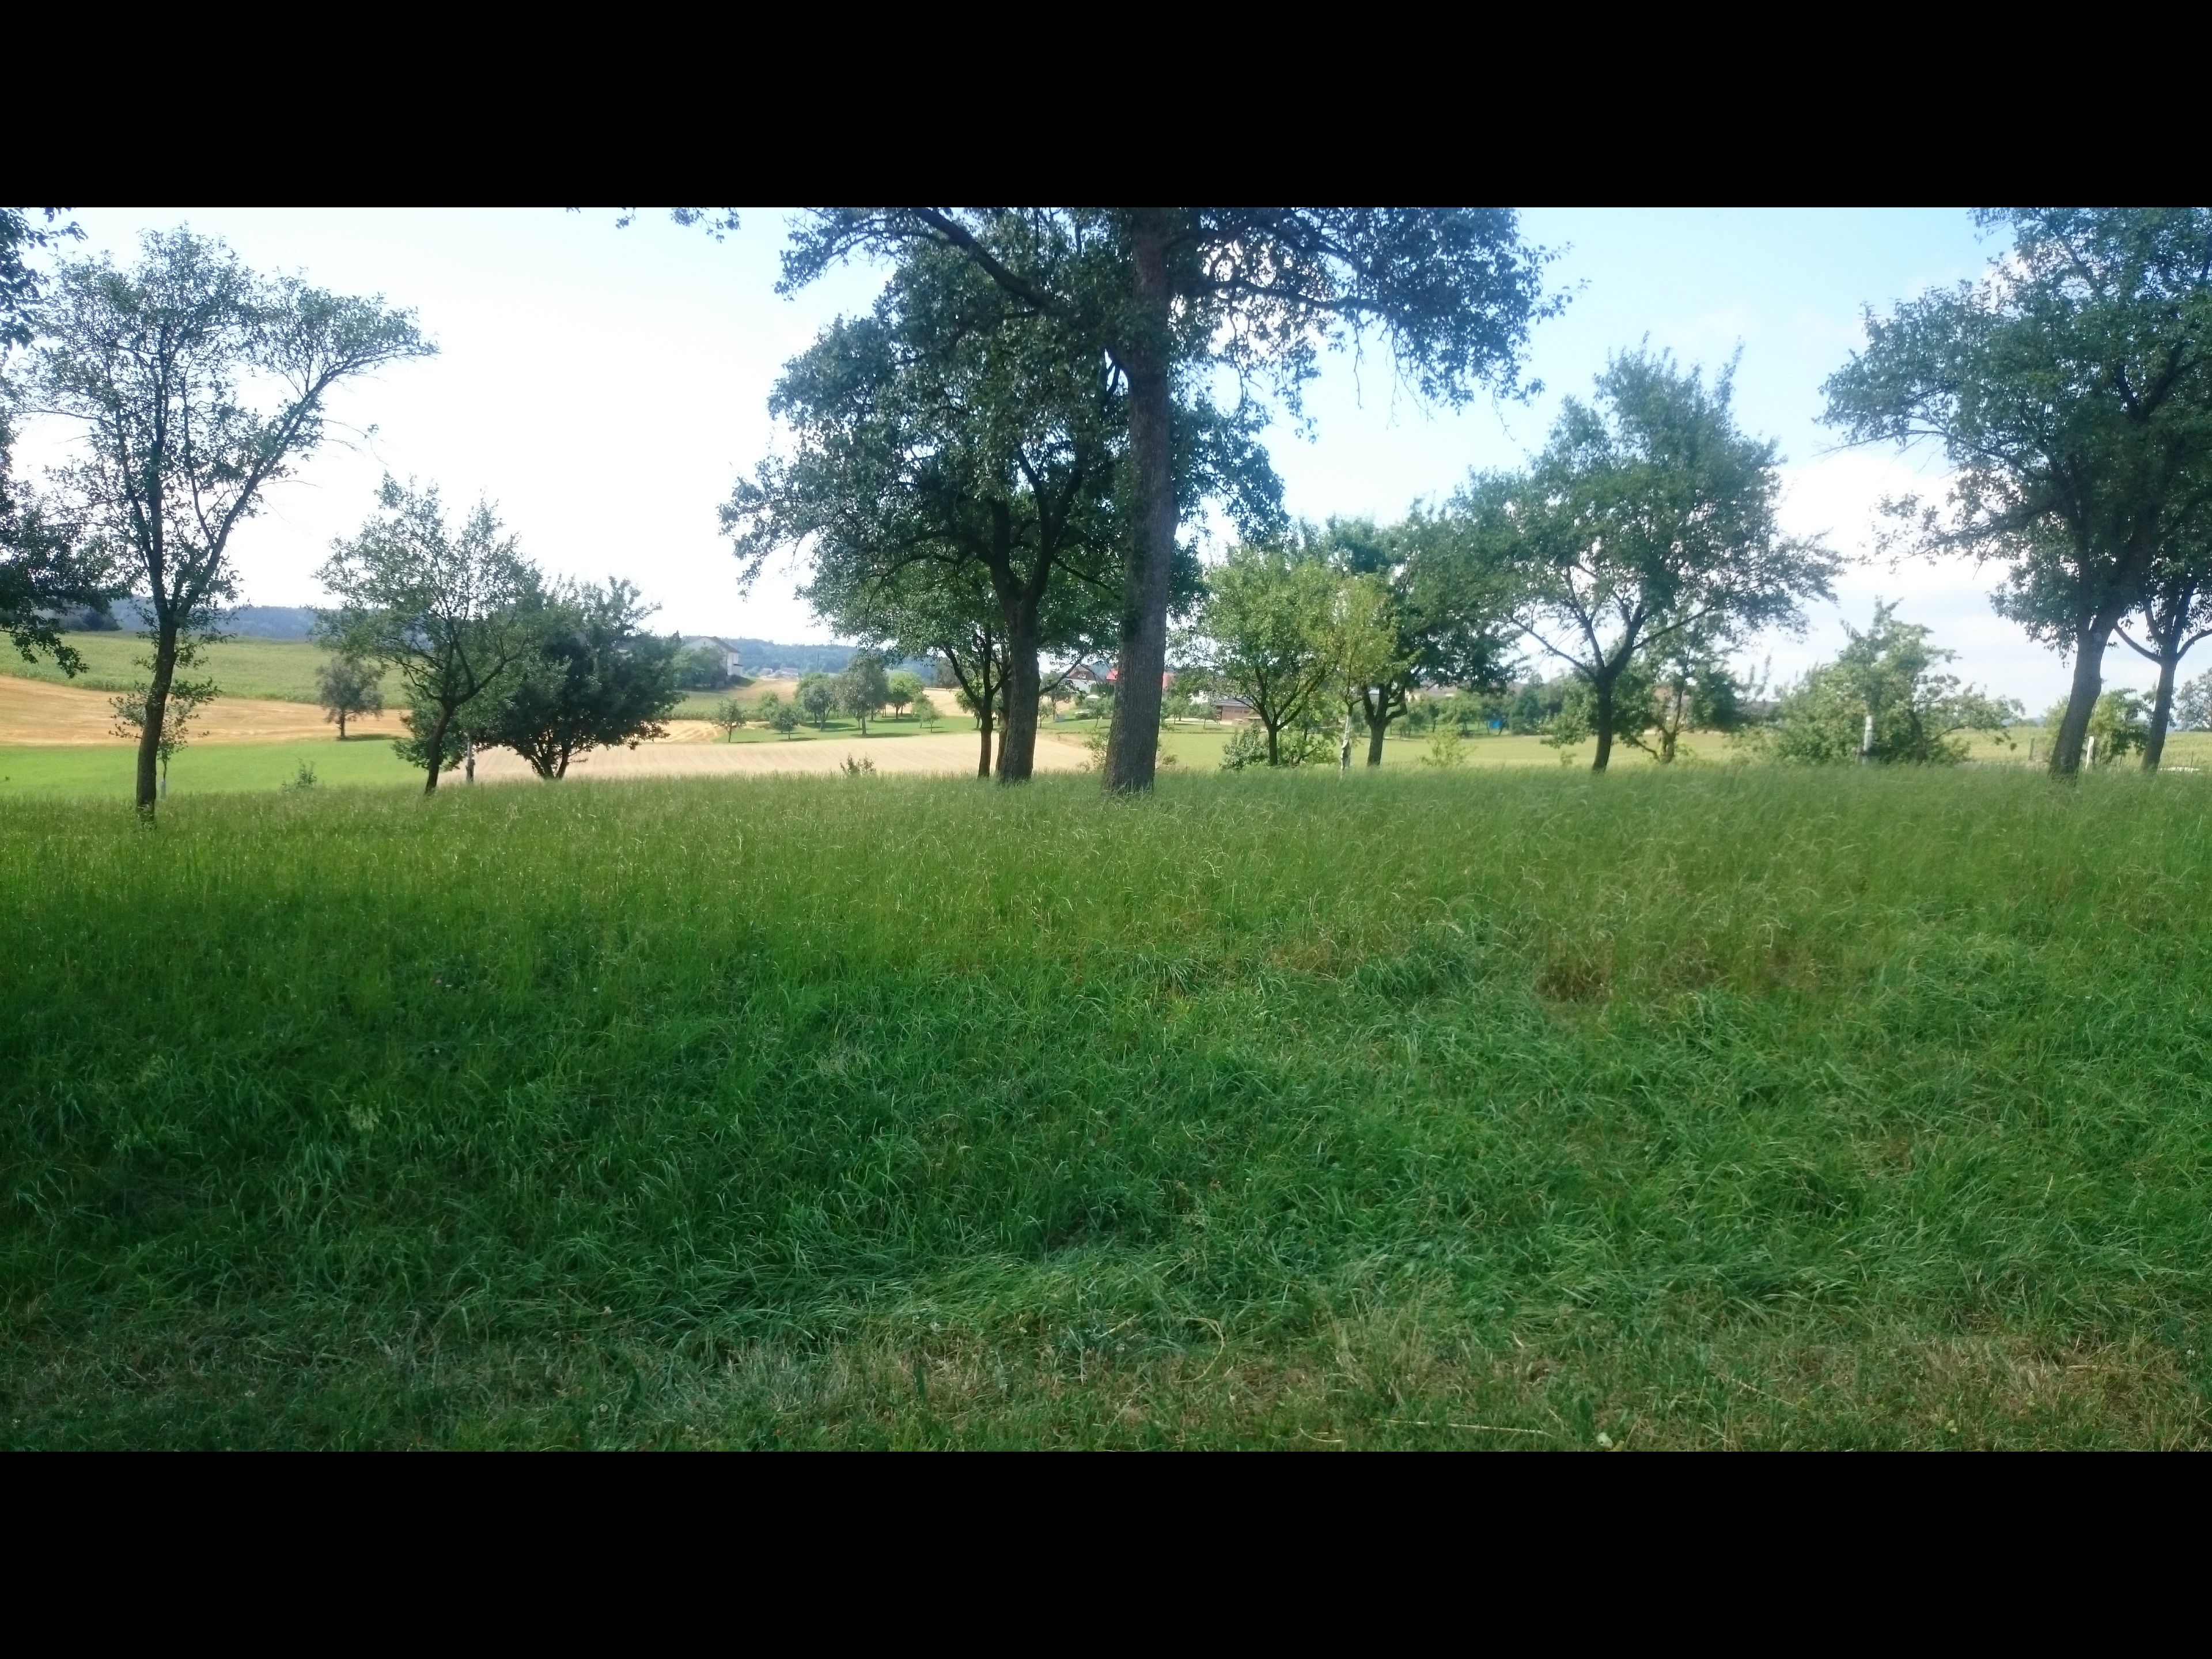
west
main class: Cropland
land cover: Barley
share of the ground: < 10 %
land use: Agriculture (excluding fallow land and kitchen gardens)
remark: Harvested field
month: July
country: AT
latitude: 48.2269
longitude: 14.8066
